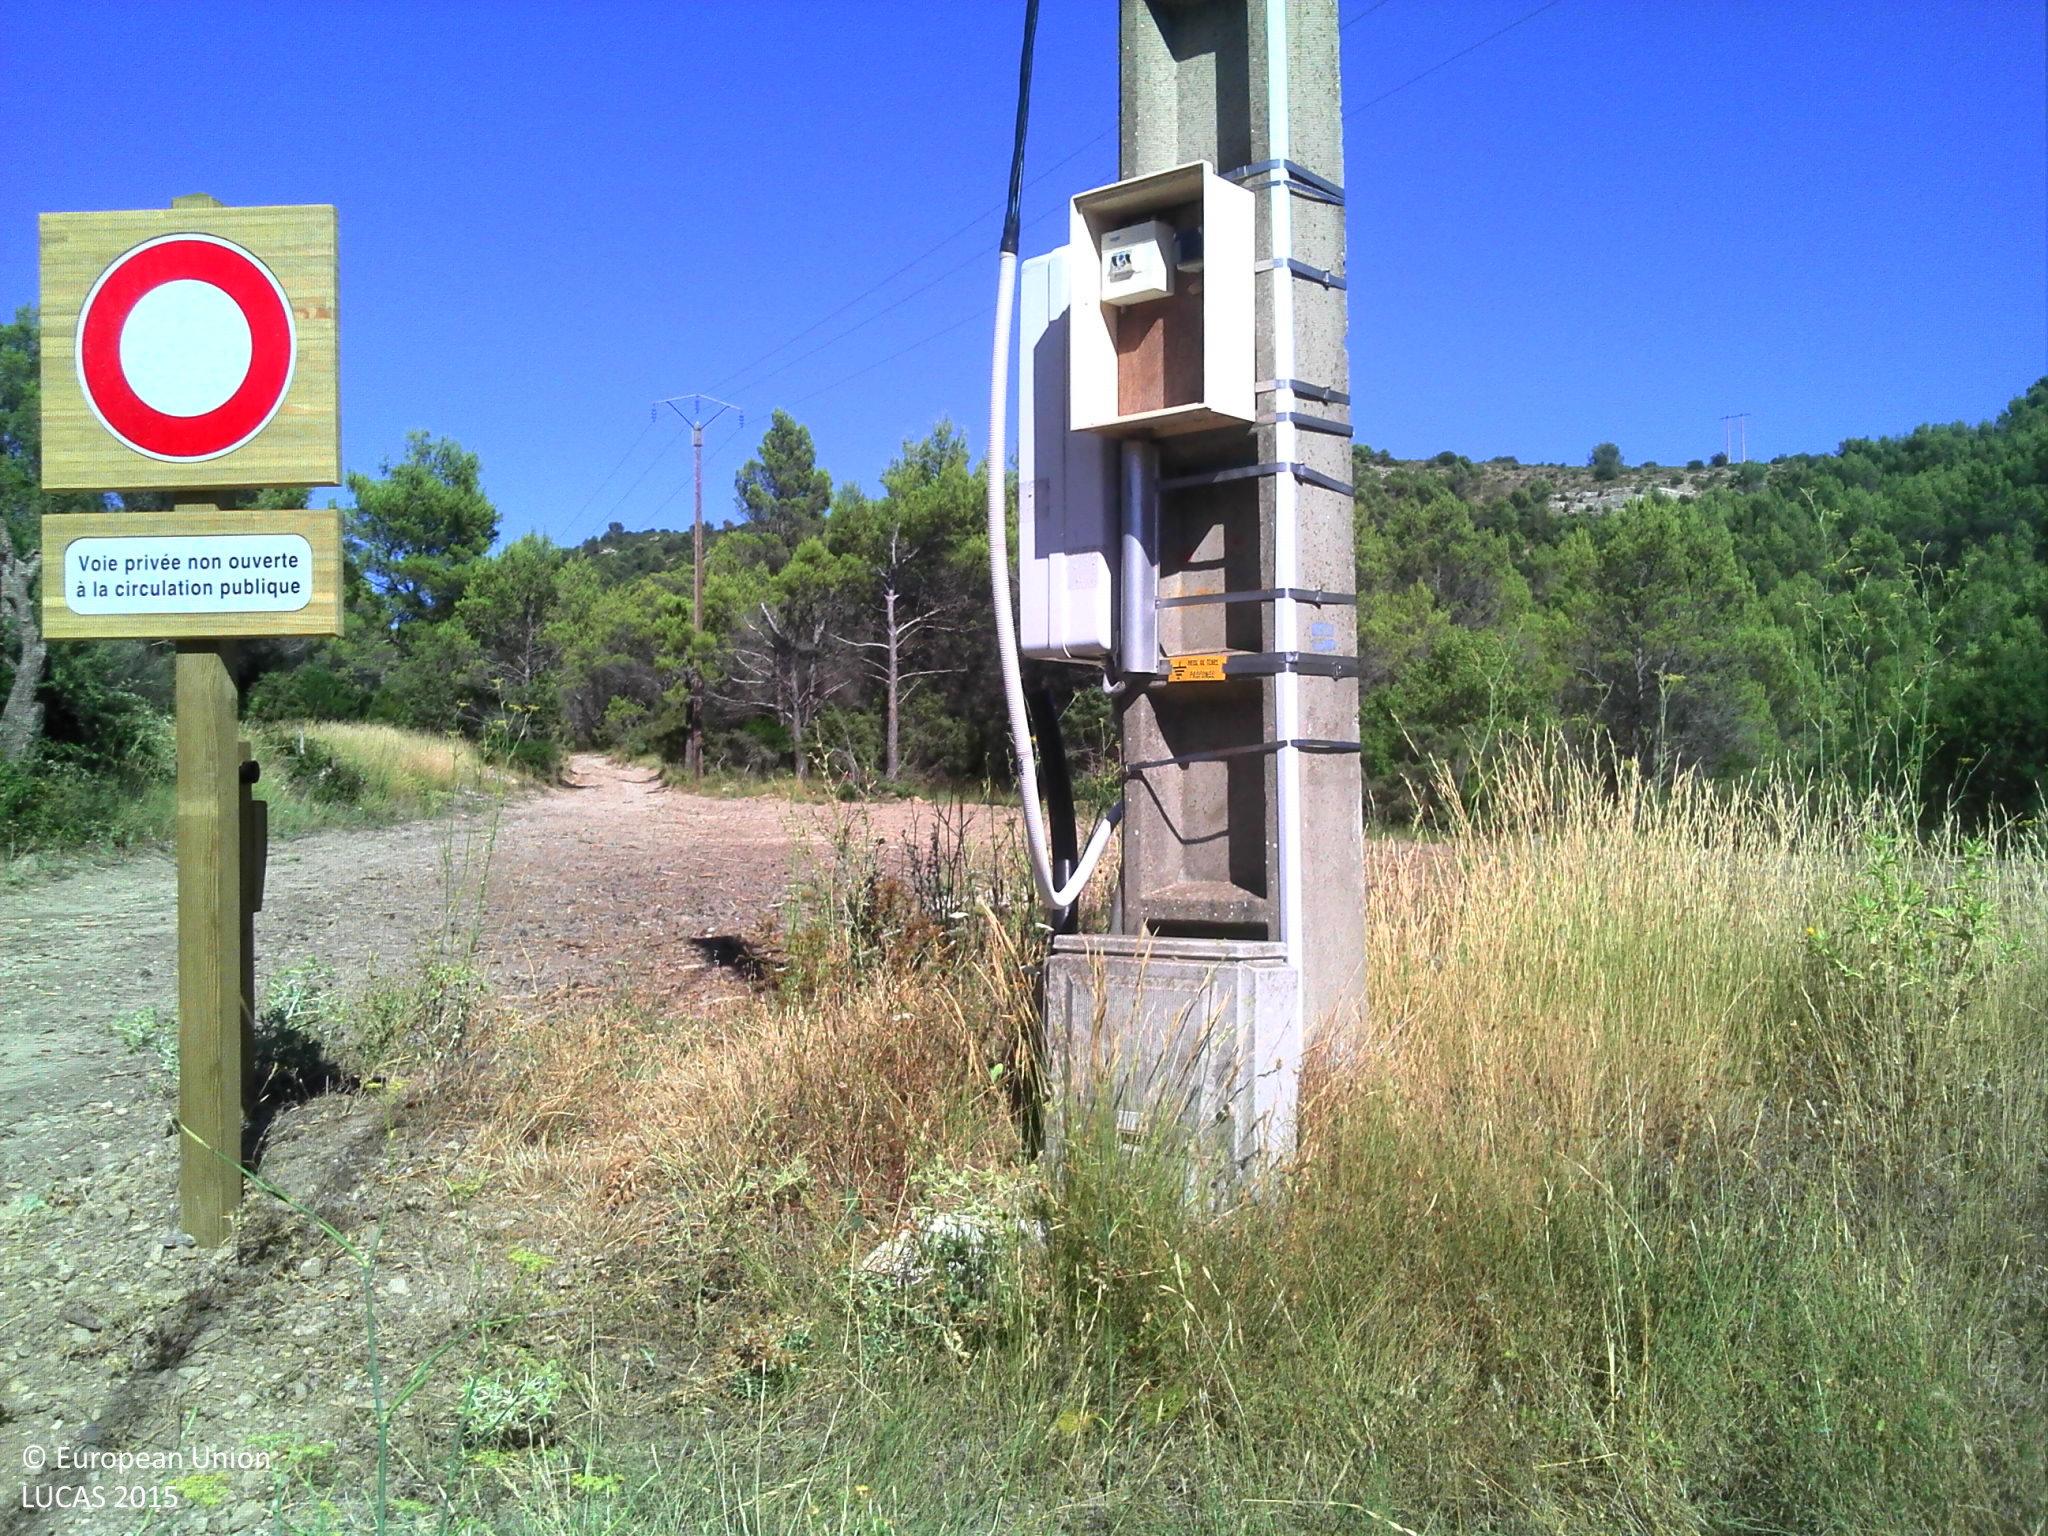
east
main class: Woodland
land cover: Pine dominated coniferous woodland
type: coniferous forest of the mediterranean region
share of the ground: > 75 %
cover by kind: coniferous forest trees 90 %, shrubs 10 %
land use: Semi-natural and natural areas not in use
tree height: > 5 m
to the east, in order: Pine dominated coniferous woodland; Tracks; Pine dominated coniferous woodland; Tracks; Pine dominated coniferous woodland; Tracks; Pine dominated coniferous woodland; Tracks; Pine dominated coniferous woodland
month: July
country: FR
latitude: 43.3073
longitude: 5.7813
